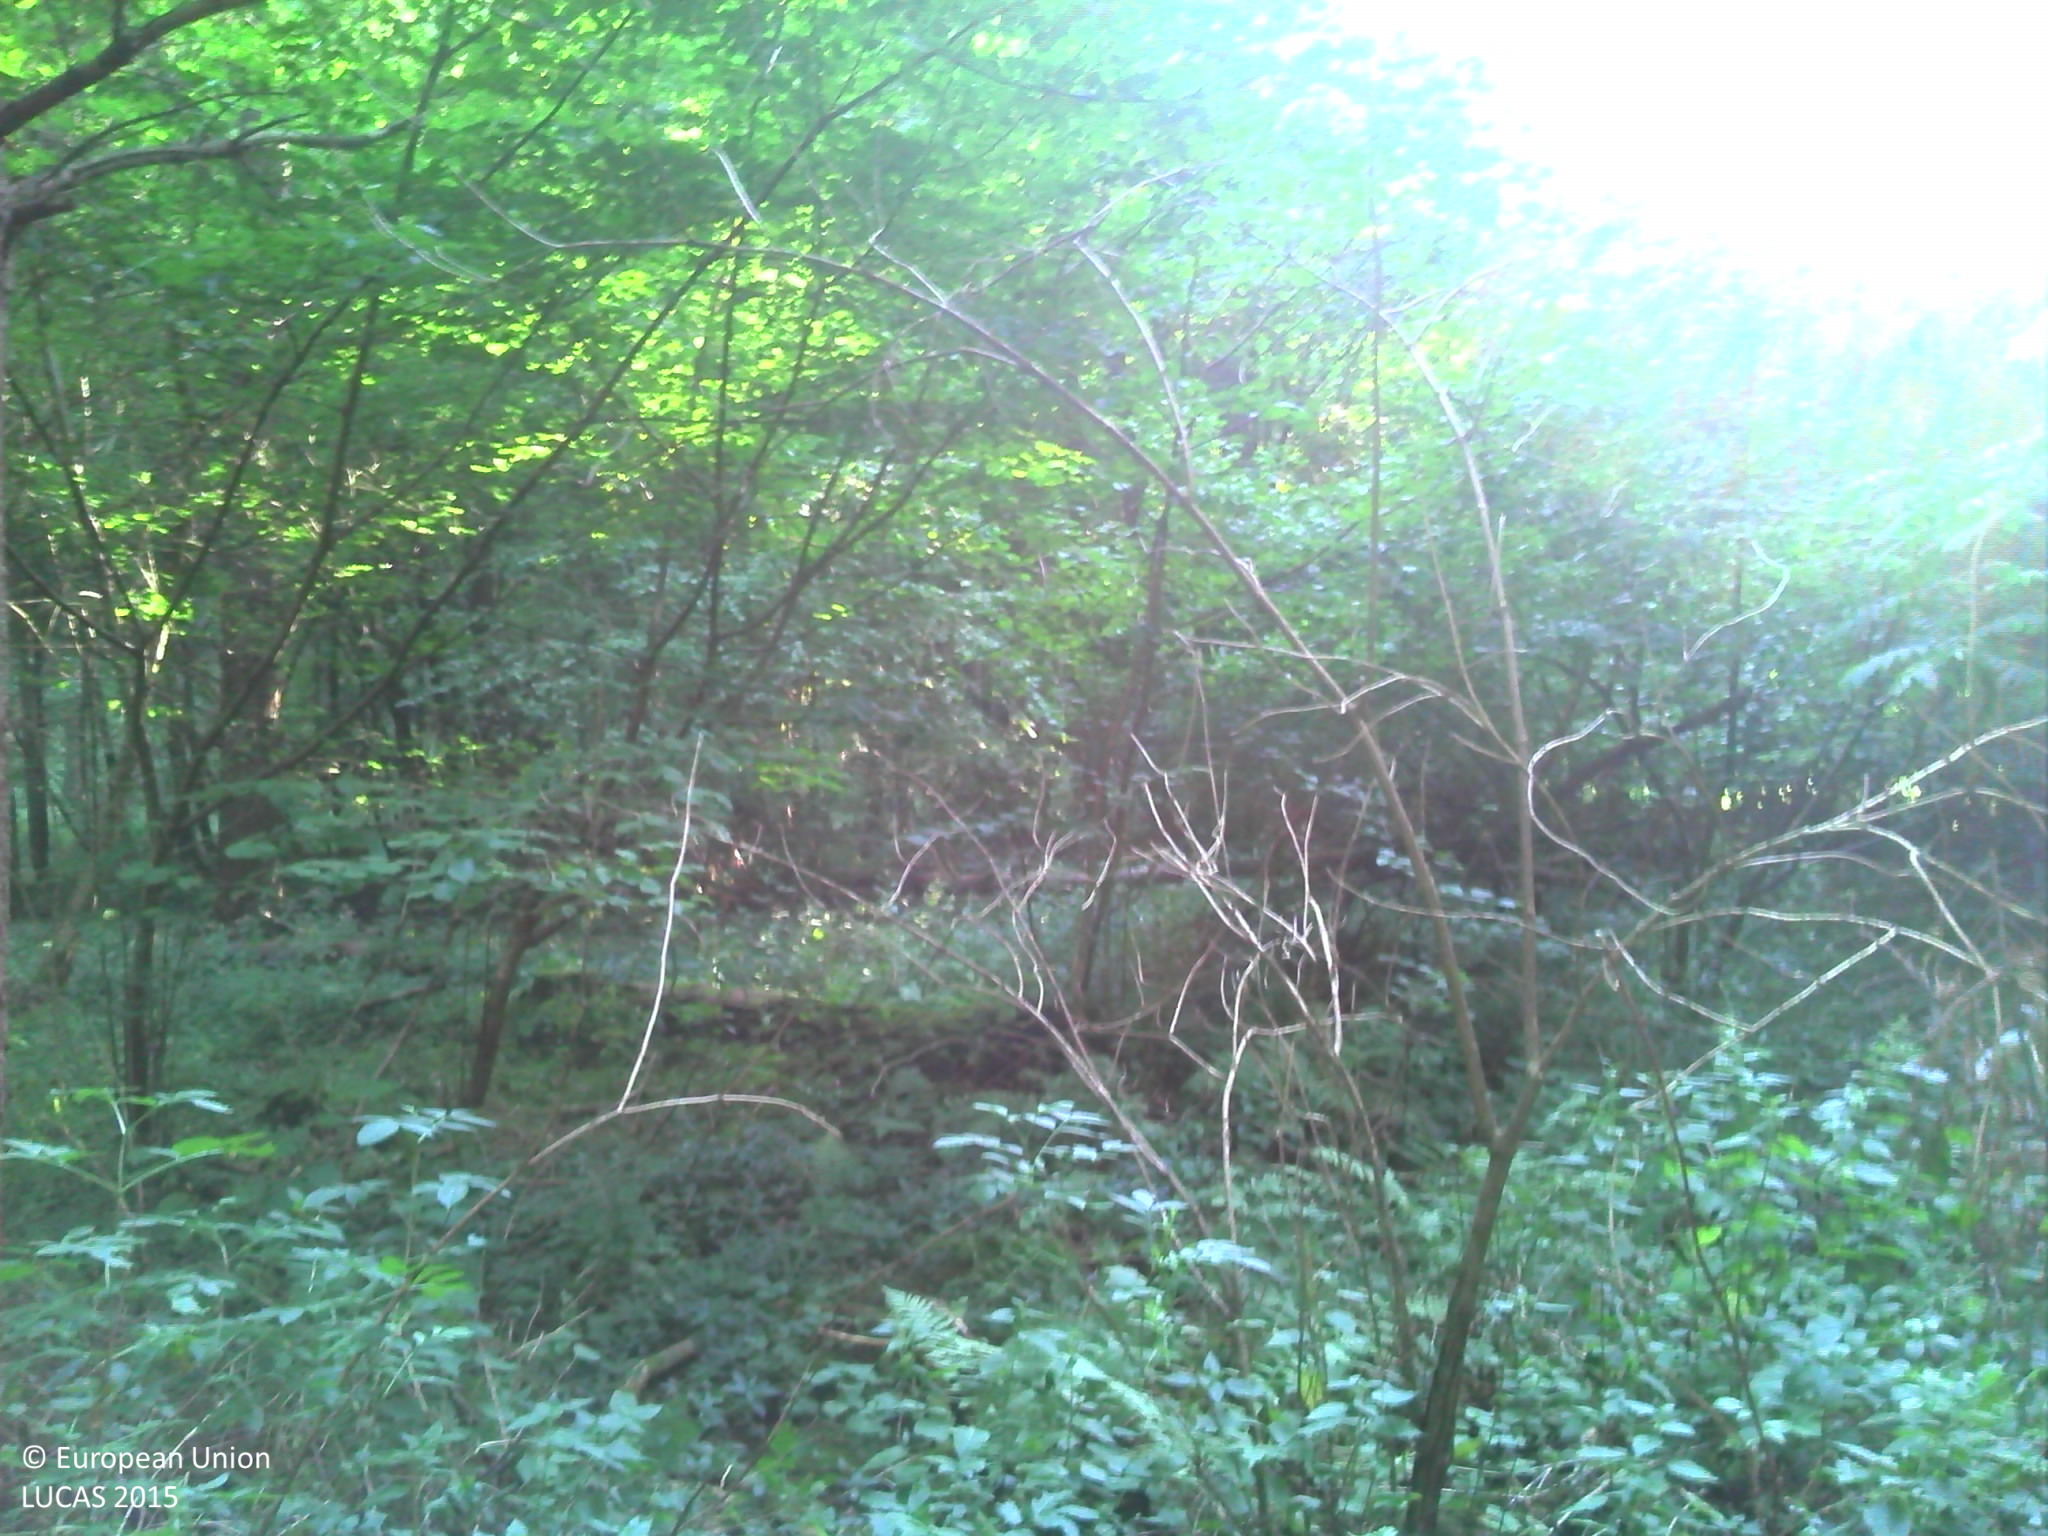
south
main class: Woodland
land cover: Spruce dominated mixed woodland
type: mesophytic deciduous forest
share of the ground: > 75 %
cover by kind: coniferous forest trees 45 %, broadleaved forest trees 20 %, consolidated bare surface 20 %, herbaceous plants 15 %
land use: Forestry
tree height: > 5 m
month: July
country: FR
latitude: 48.8761
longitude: 1.3229
